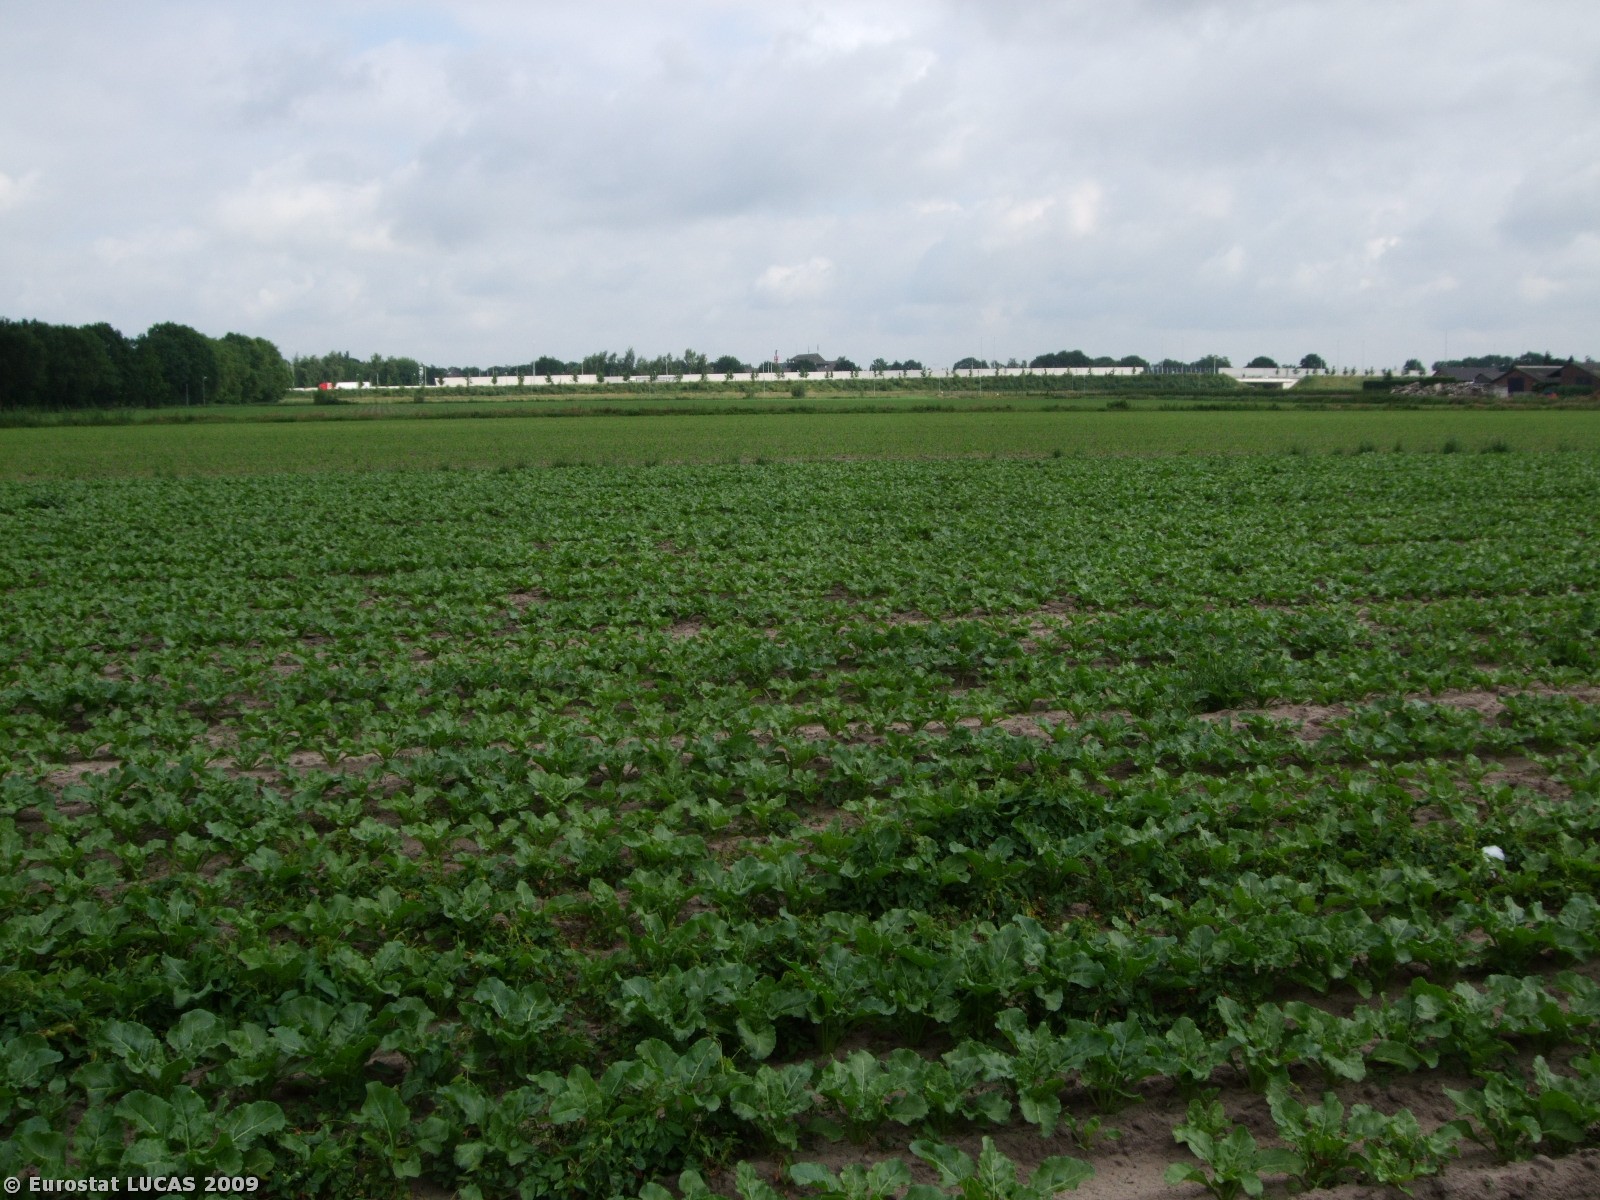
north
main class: Cropland
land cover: Sugar beet
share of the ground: 50 - 75 %
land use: Agriculture (excluding fallow land and kitchen gardens)
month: May
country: NL
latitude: 51.7137
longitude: 5.4390
